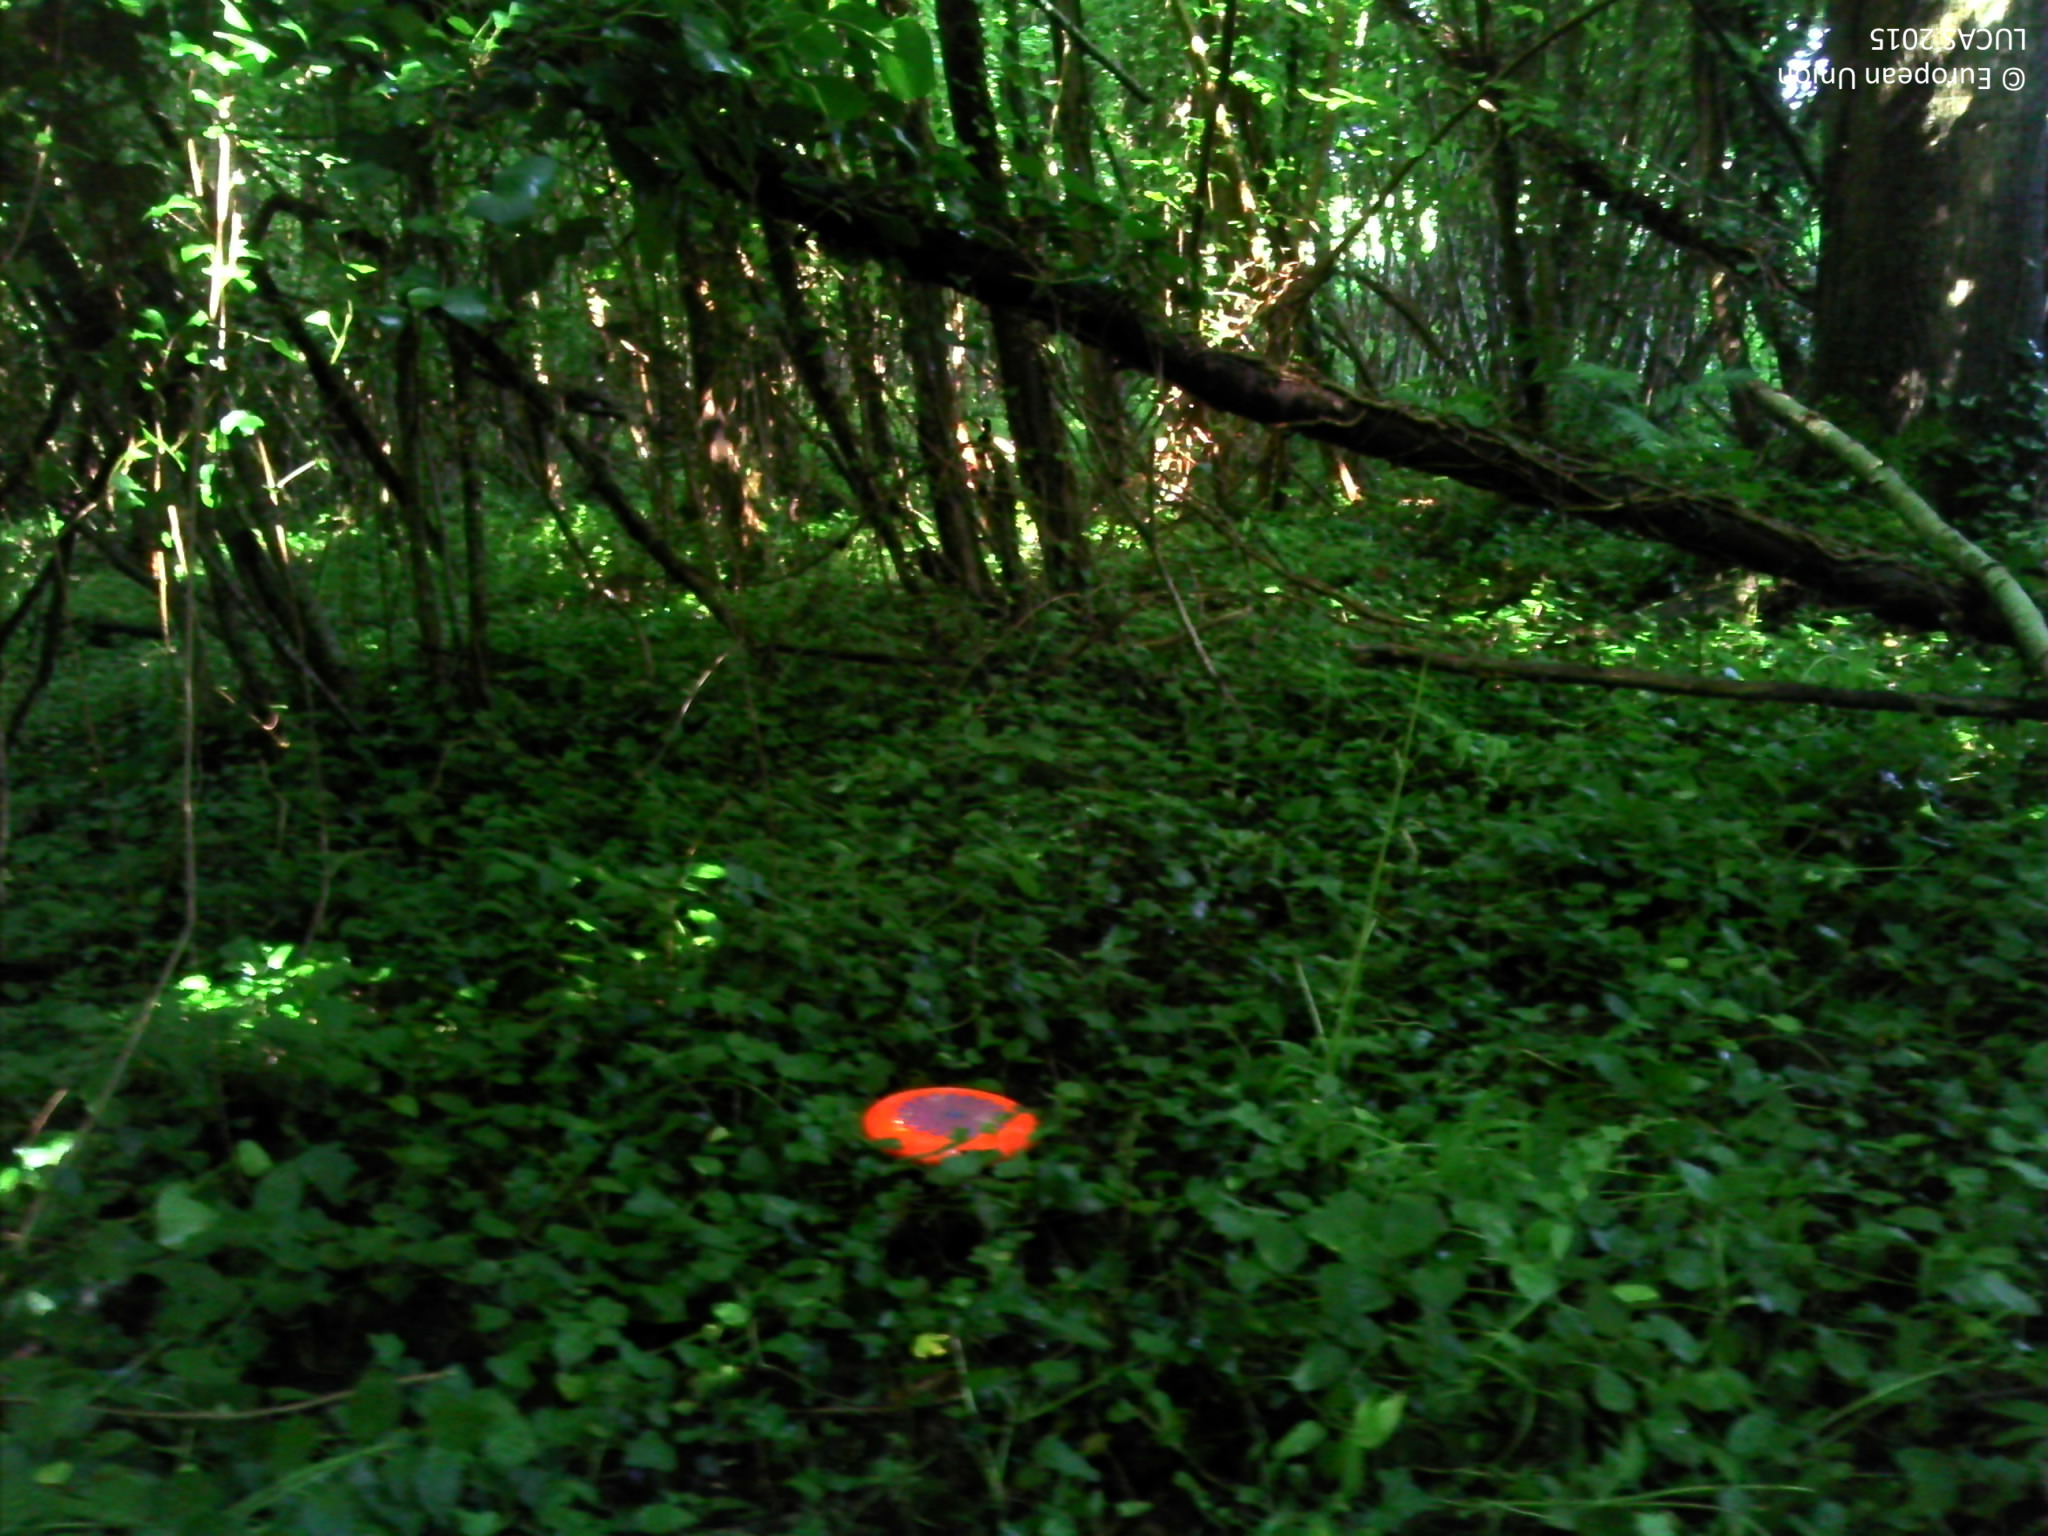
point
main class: Woodland
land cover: Broadleaved woodland
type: mesophytic deciduous forest
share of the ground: > 75 %
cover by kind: herbaceous plants 60 %, broadleaved forest trees 25 %, lichens and mosses 10 %
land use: Forestry
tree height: > 5 m
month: July
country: FR
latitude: 48.2743
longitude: -2.1688
